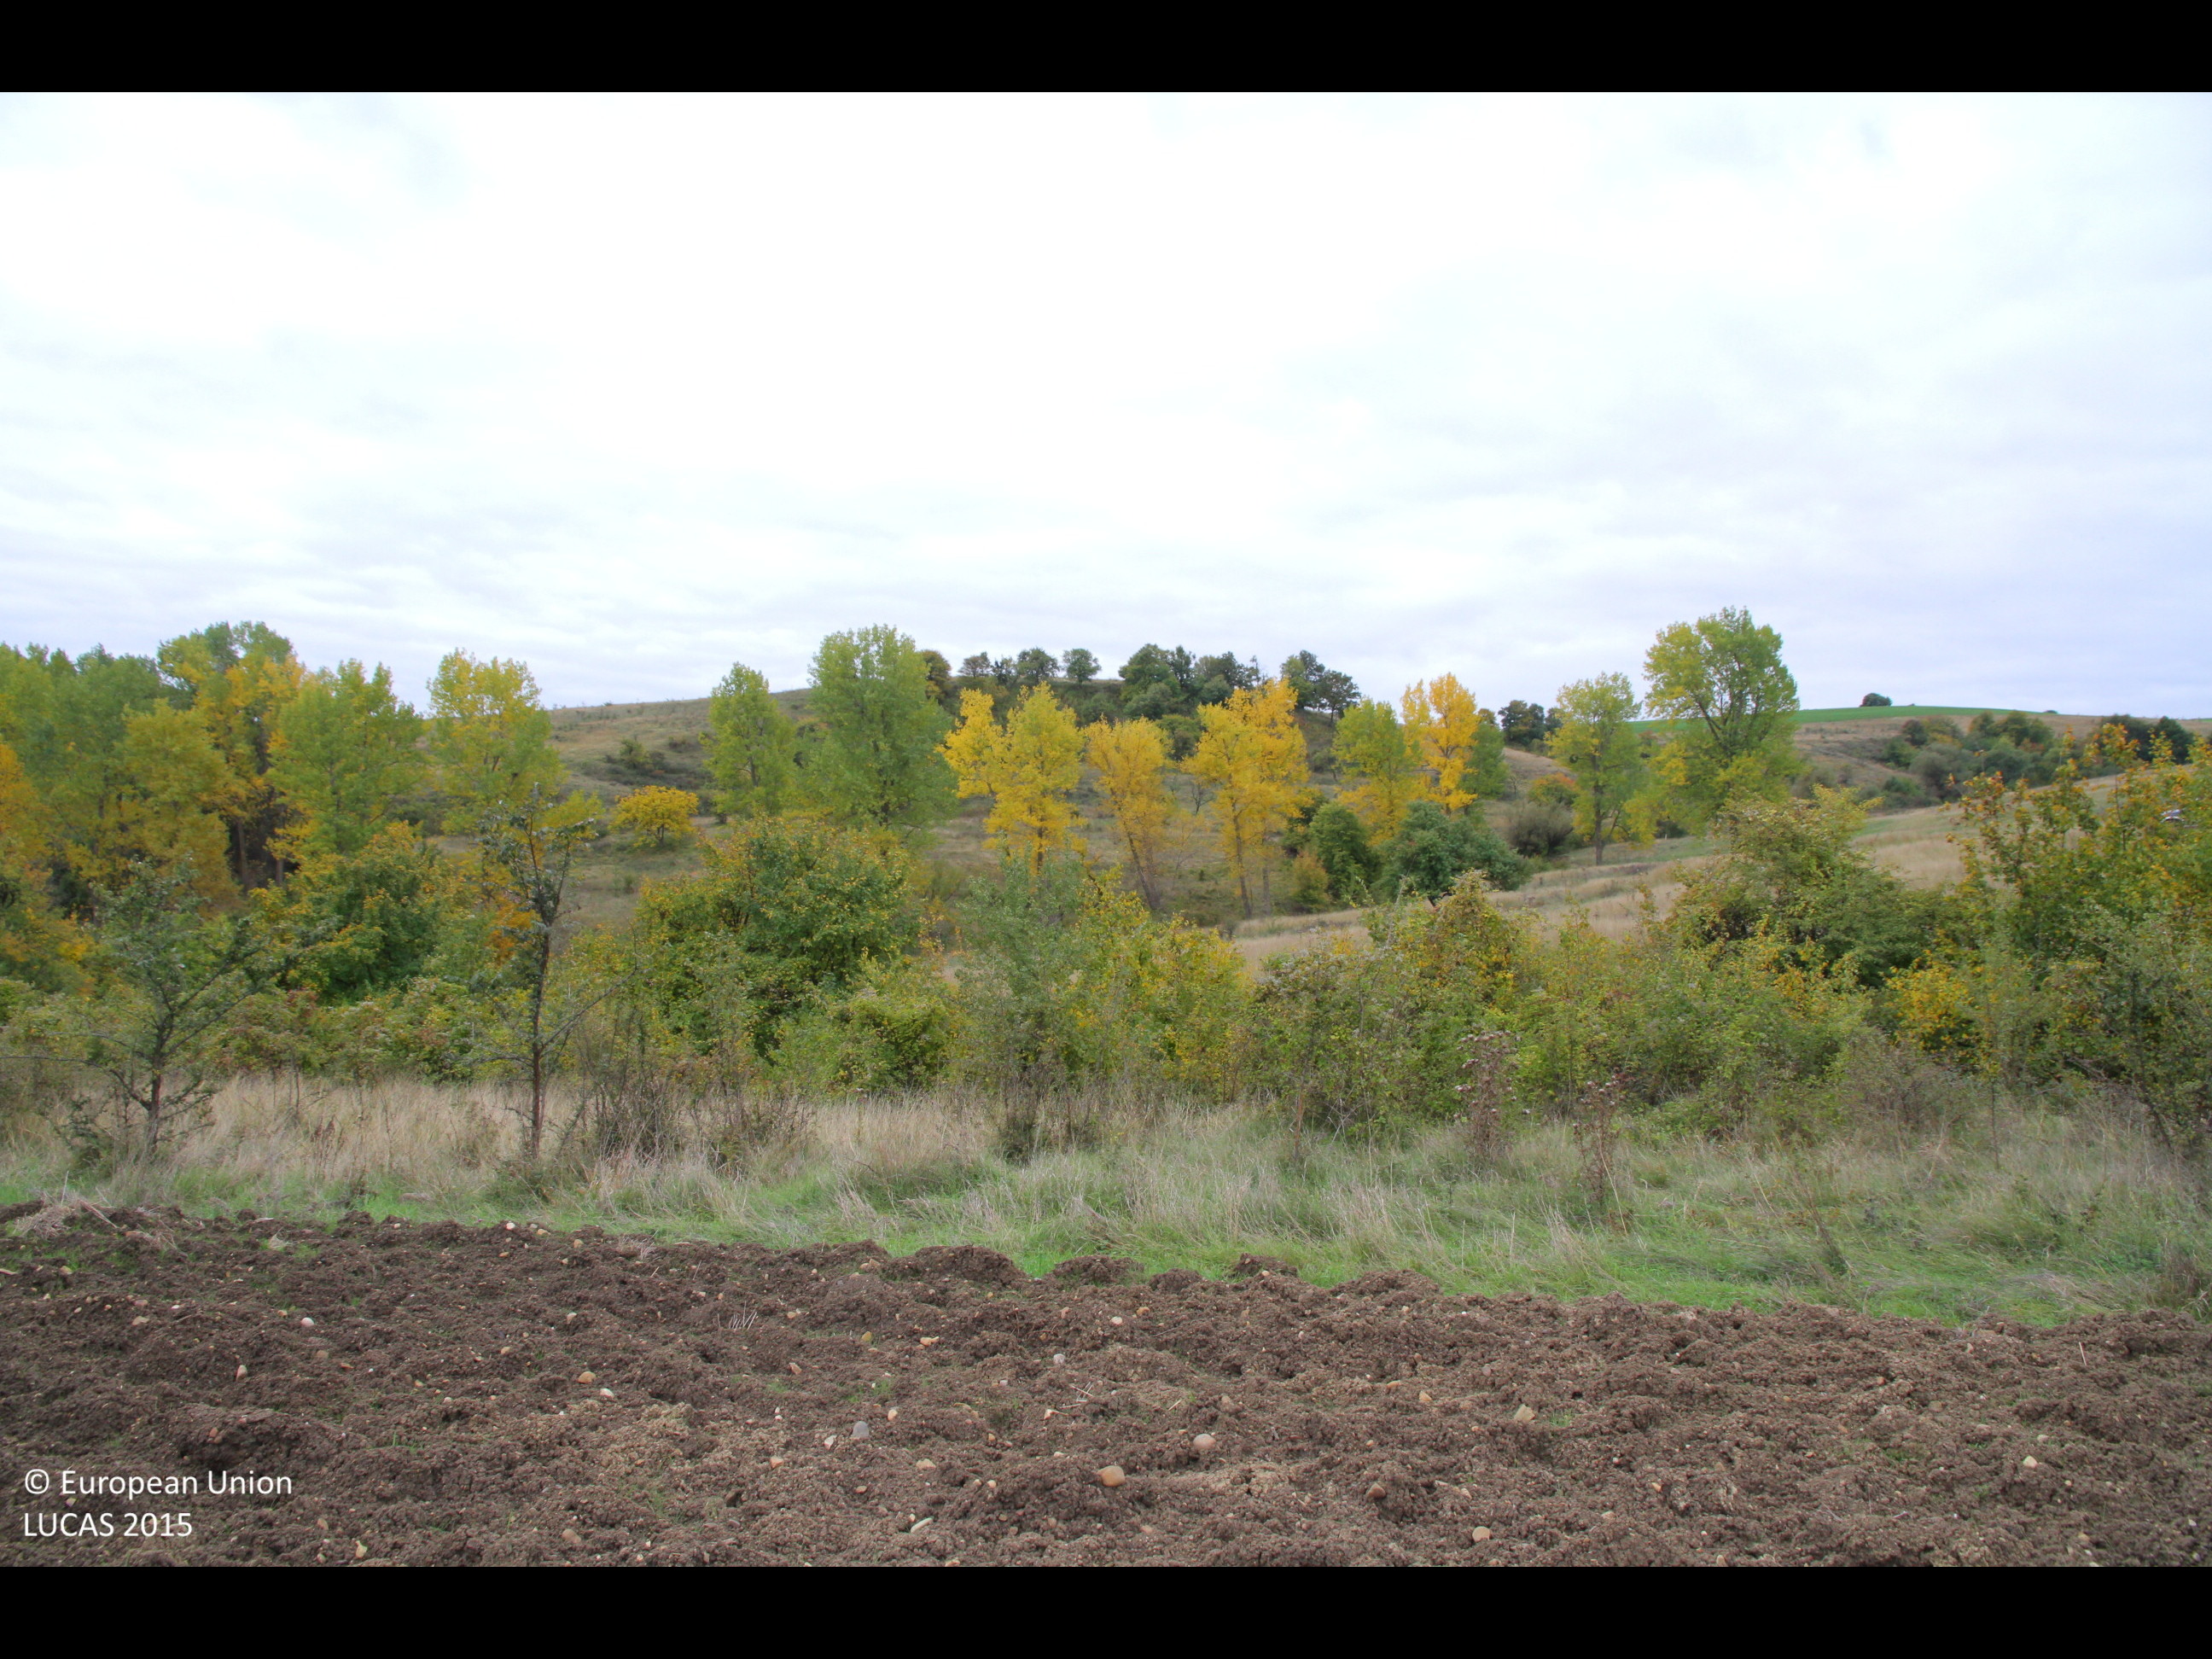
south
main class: Cropland
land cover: Common wheat
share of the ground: < 10 %
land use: Agriculture (excluding fallow land and kitchen gardens)
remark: Harvested field
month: October
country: BG
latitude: 43.1278
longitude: 27.1665
